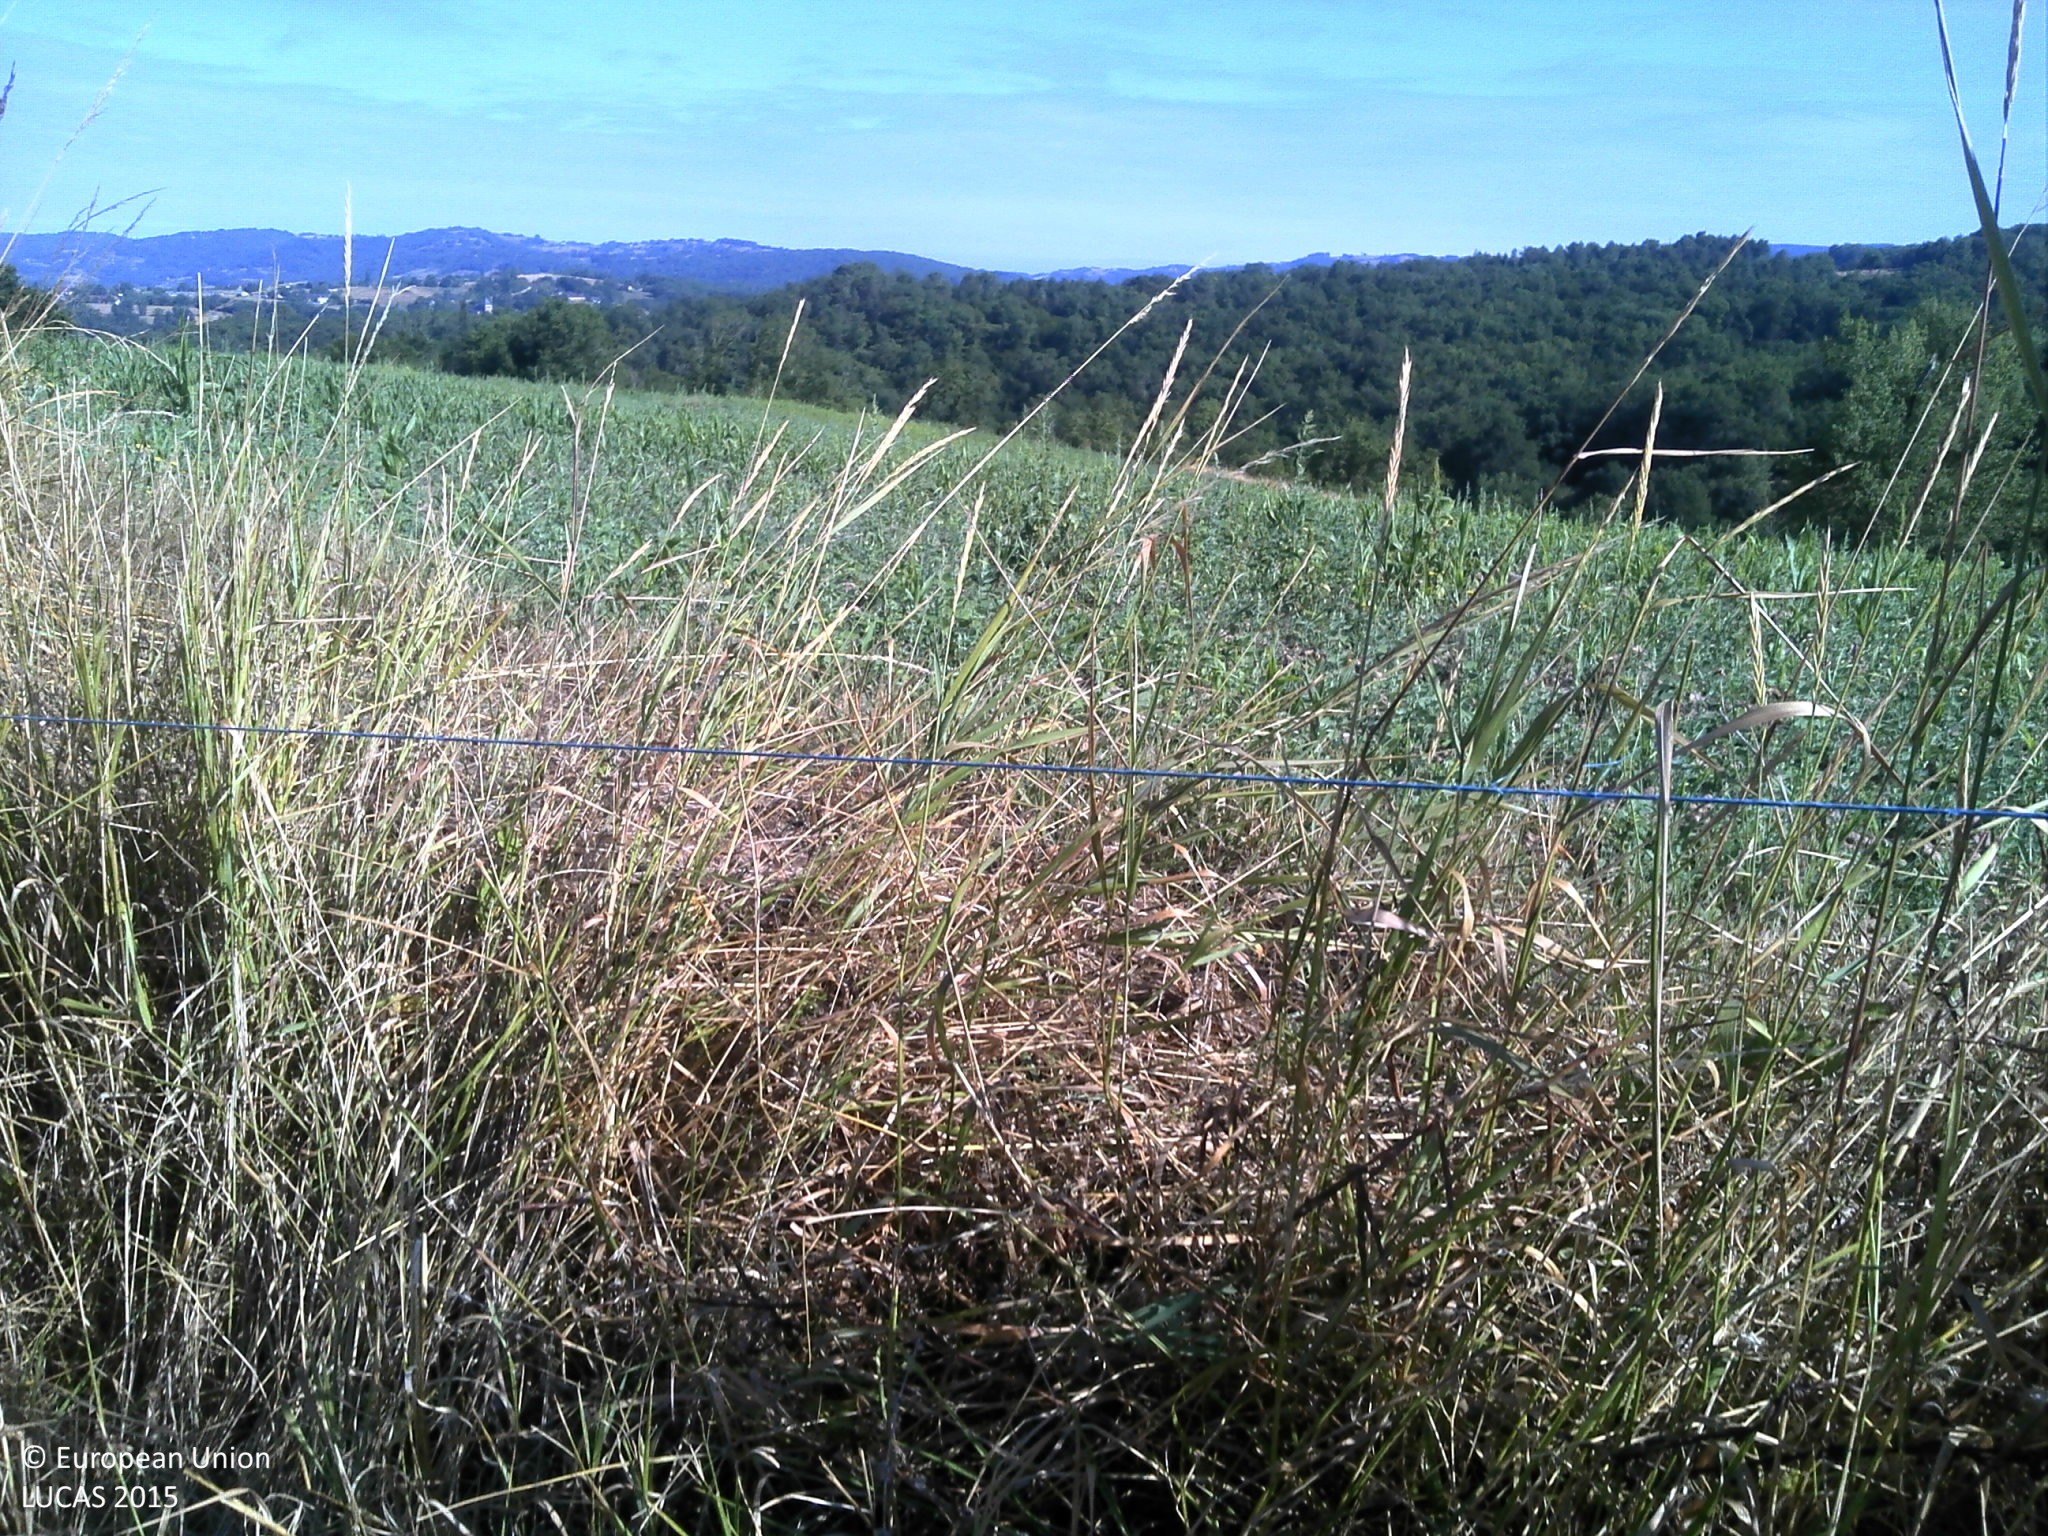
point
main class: Cropland
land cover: Mixed cereals for fodder
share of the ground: > 75 %
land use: Agriculture (excluding fallow land and kitchen gardens)
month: July
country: FR
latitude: 45.0190
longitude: 1.7613
